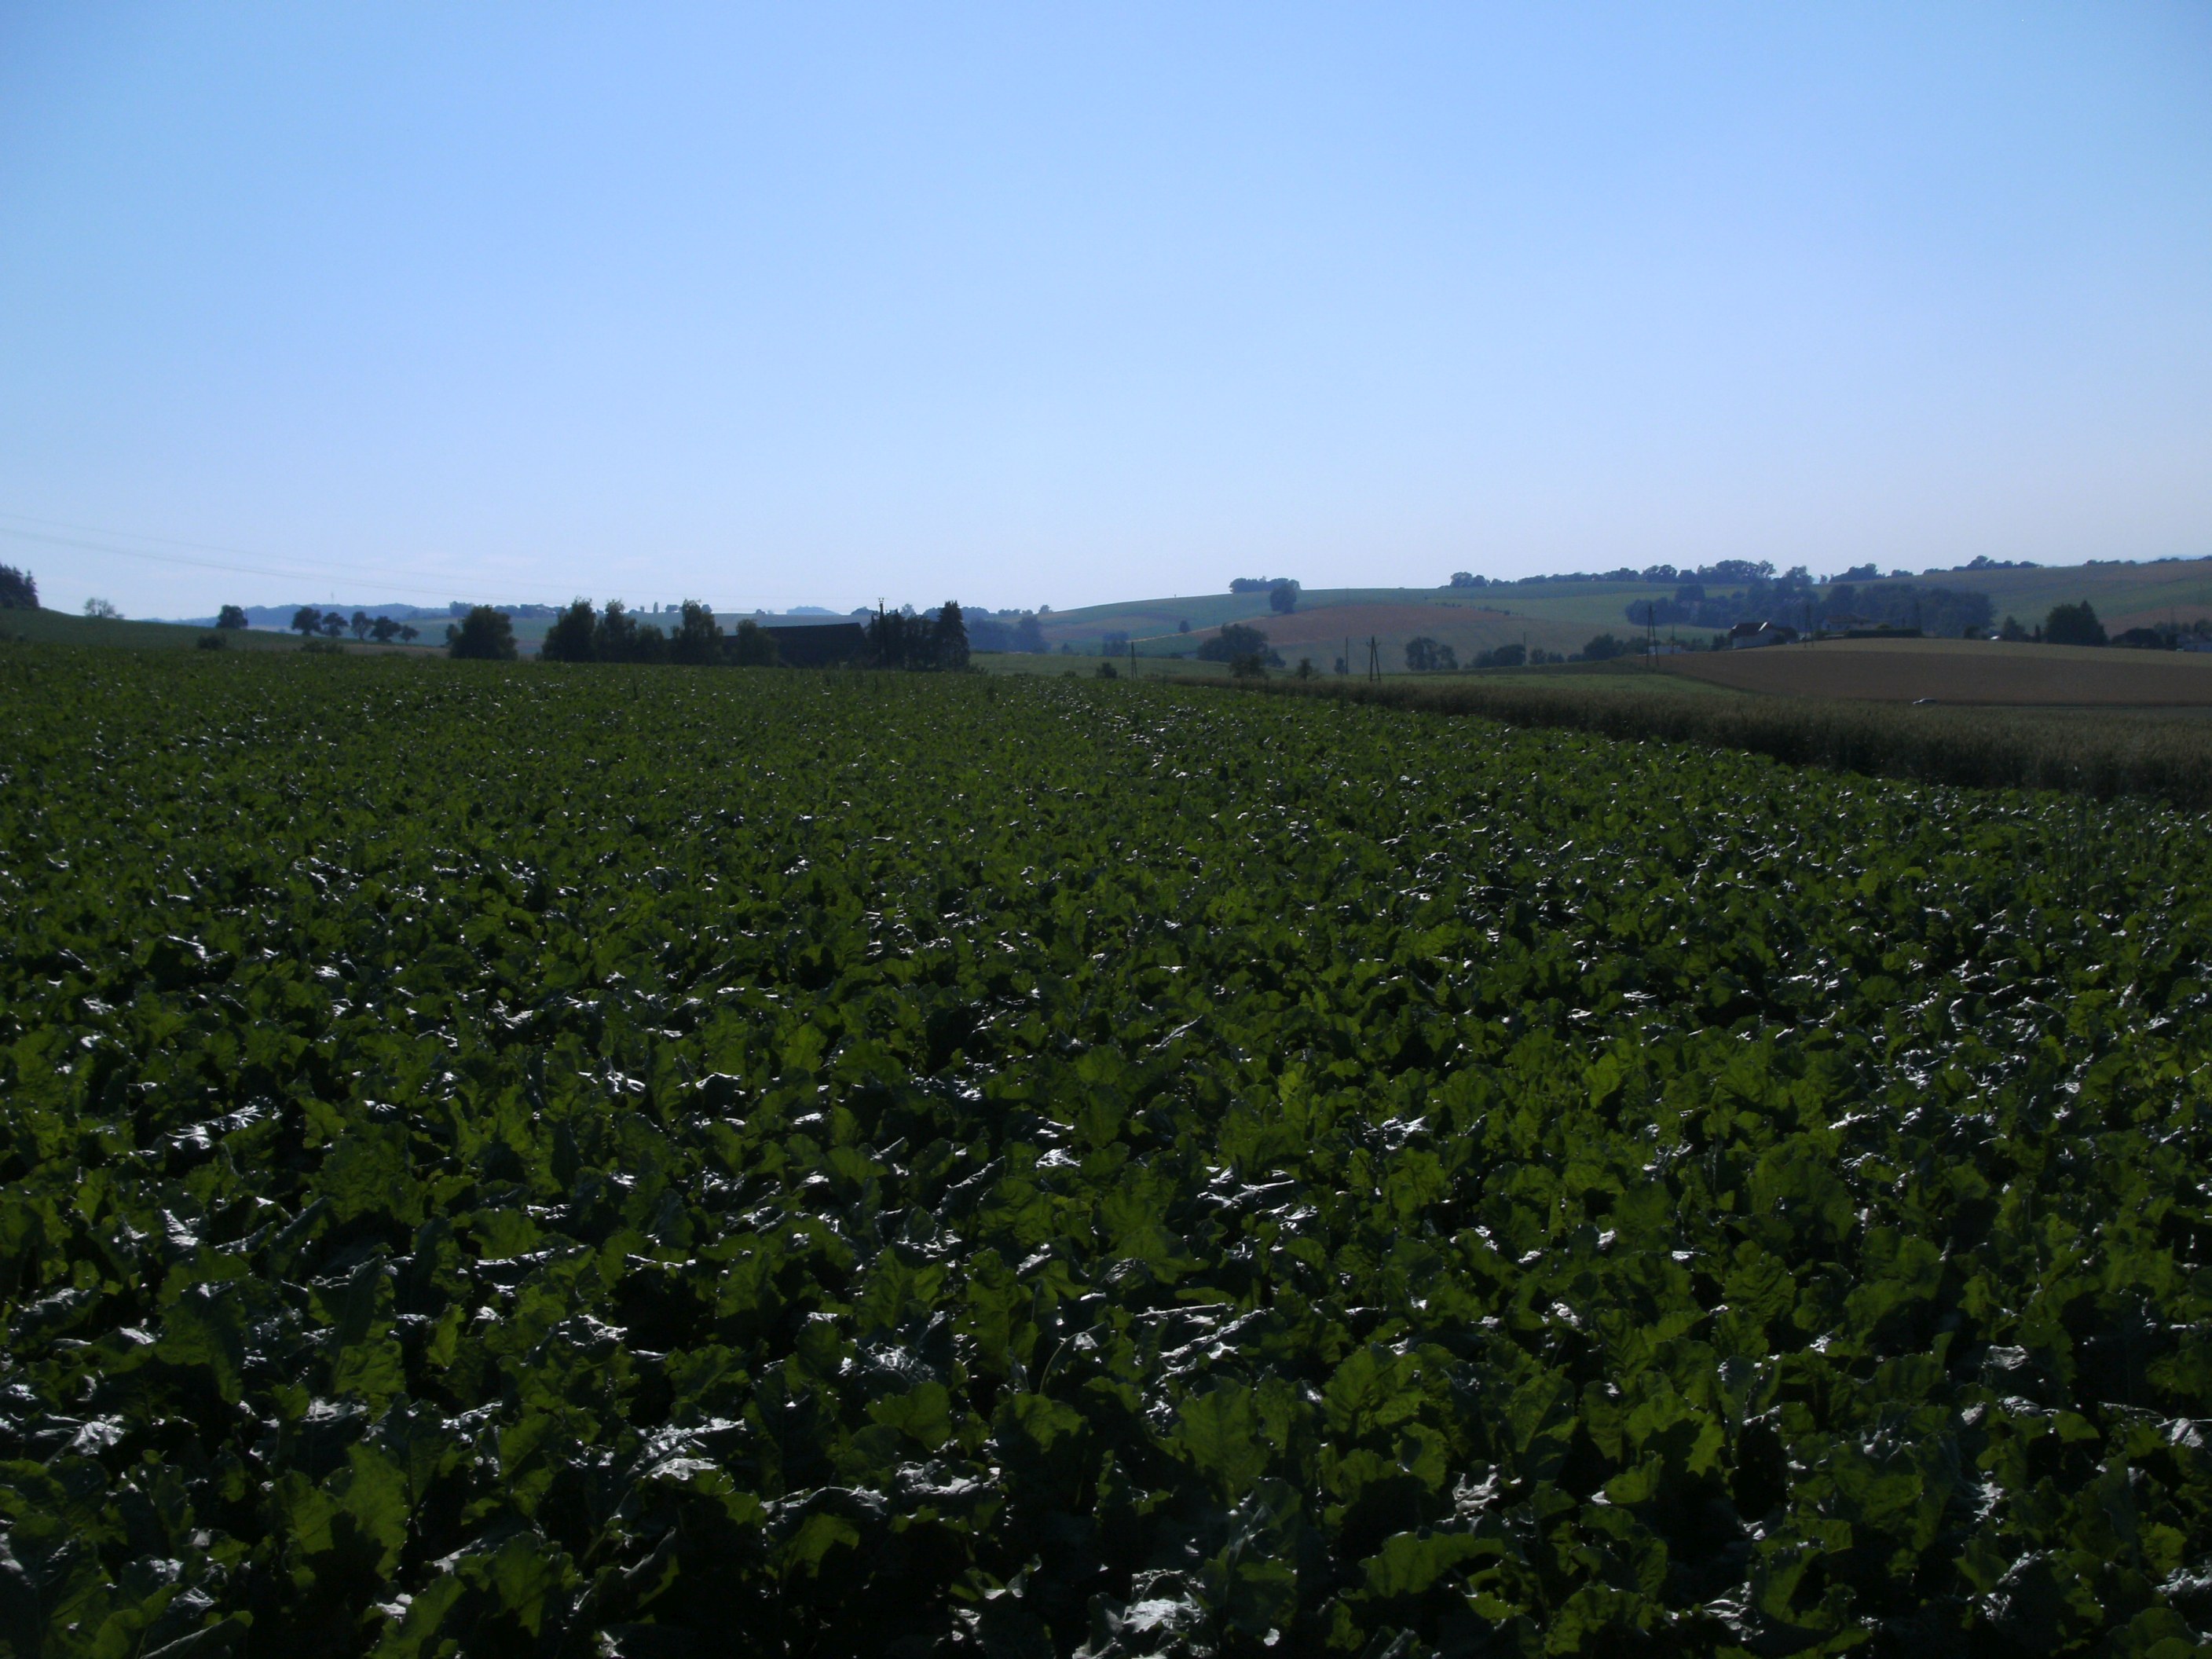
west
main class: Cropland
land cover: Soya
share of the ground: > 75 %
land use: Agriculture (excluding fallow land and kitchen gardens)
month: July
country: AT
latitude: 48.2711
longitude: 14.1632
